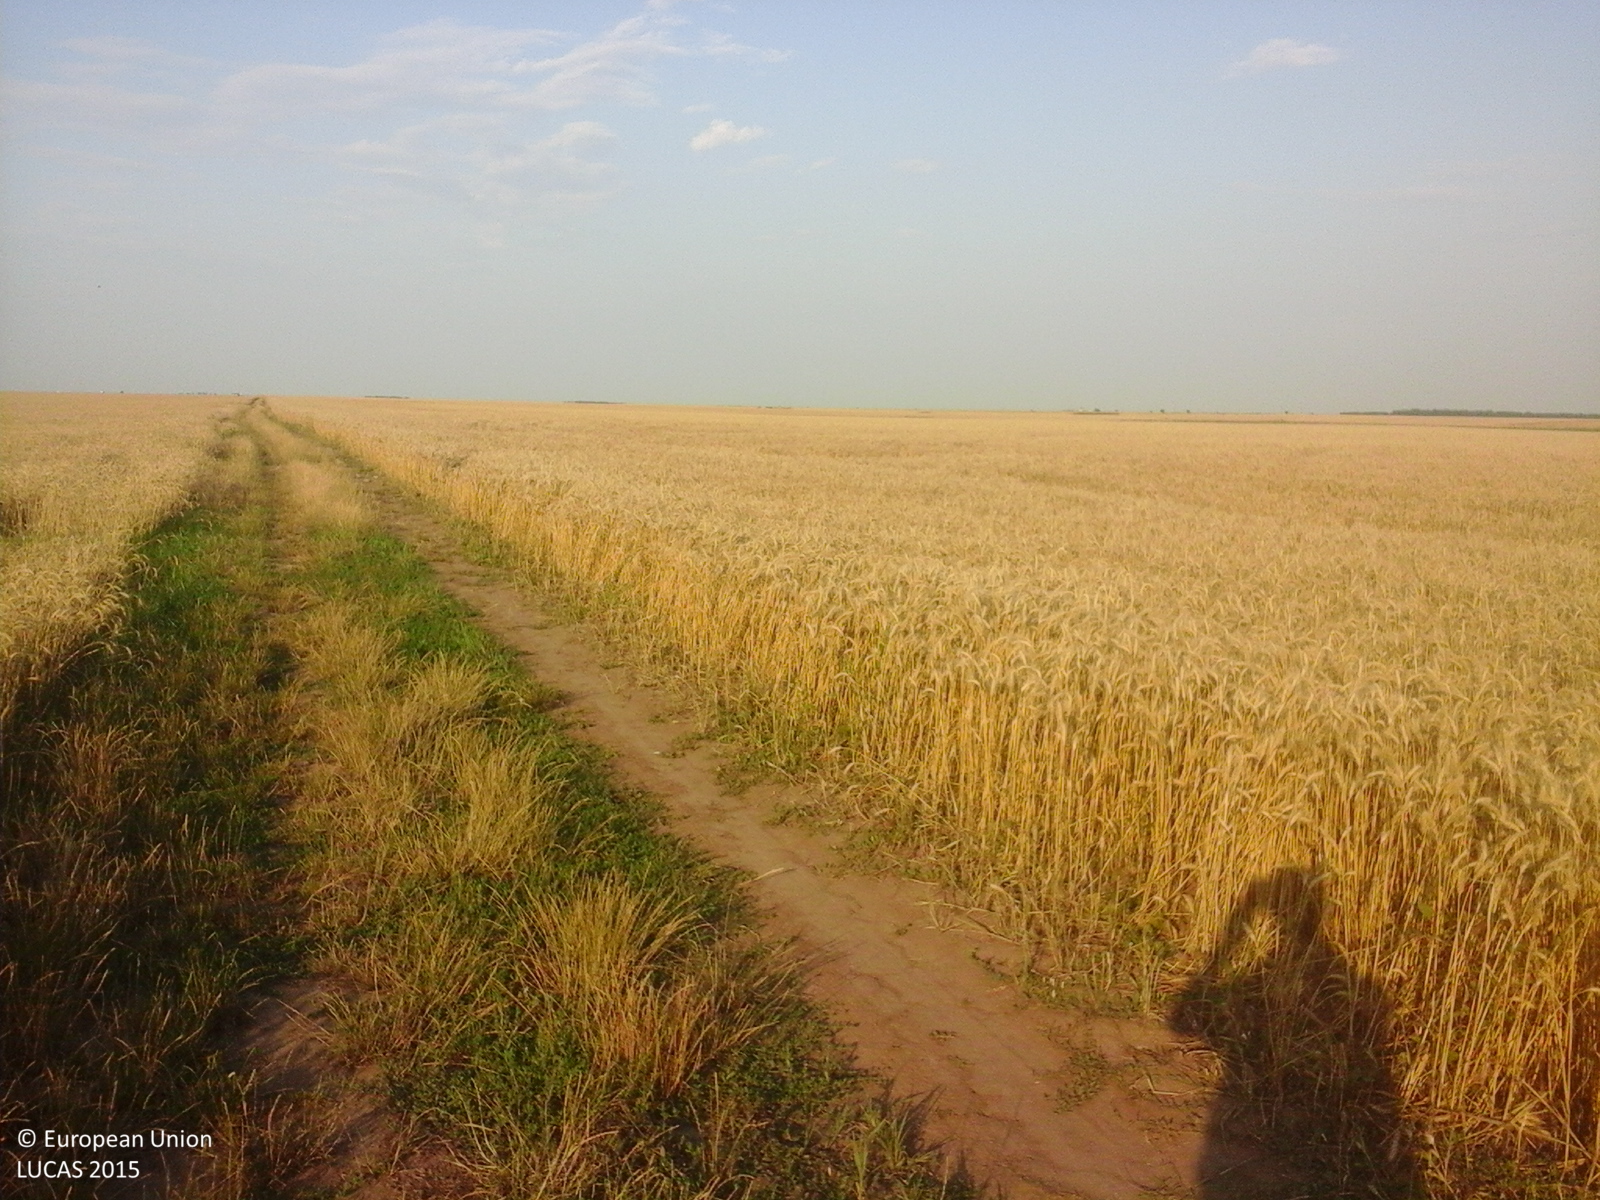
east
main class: Cropland
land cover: Common wheat
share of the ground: > 75 %
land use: Agriculture (excluding fallow land and kitchen gardens)
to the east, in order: Common wheat
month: July
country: RO
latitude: 43.9261
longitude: 24.7810
